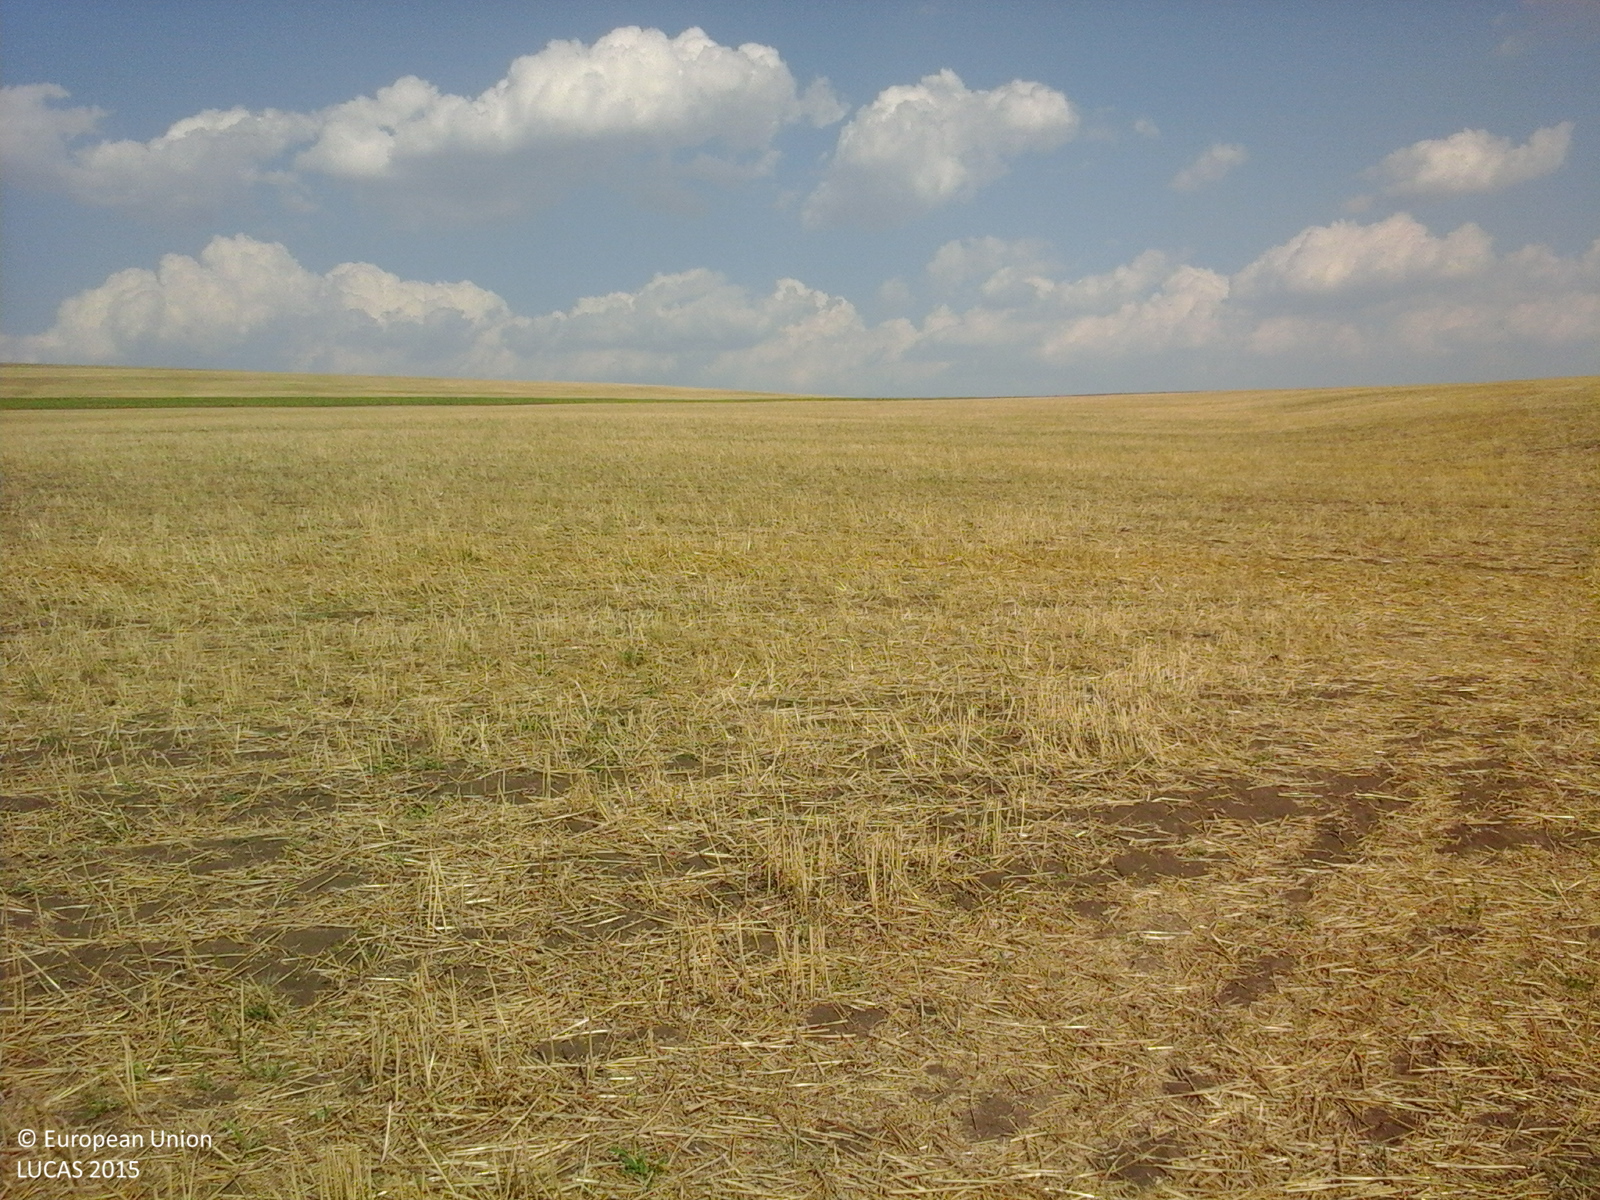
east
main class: Cropland
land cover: Common wheat
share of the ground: < 10 %
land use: Agriculture (excluding fallow land and kitchen gardens)
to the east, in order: Common wheat
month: July
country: RO
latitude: 46.3612
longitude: 27.7548
